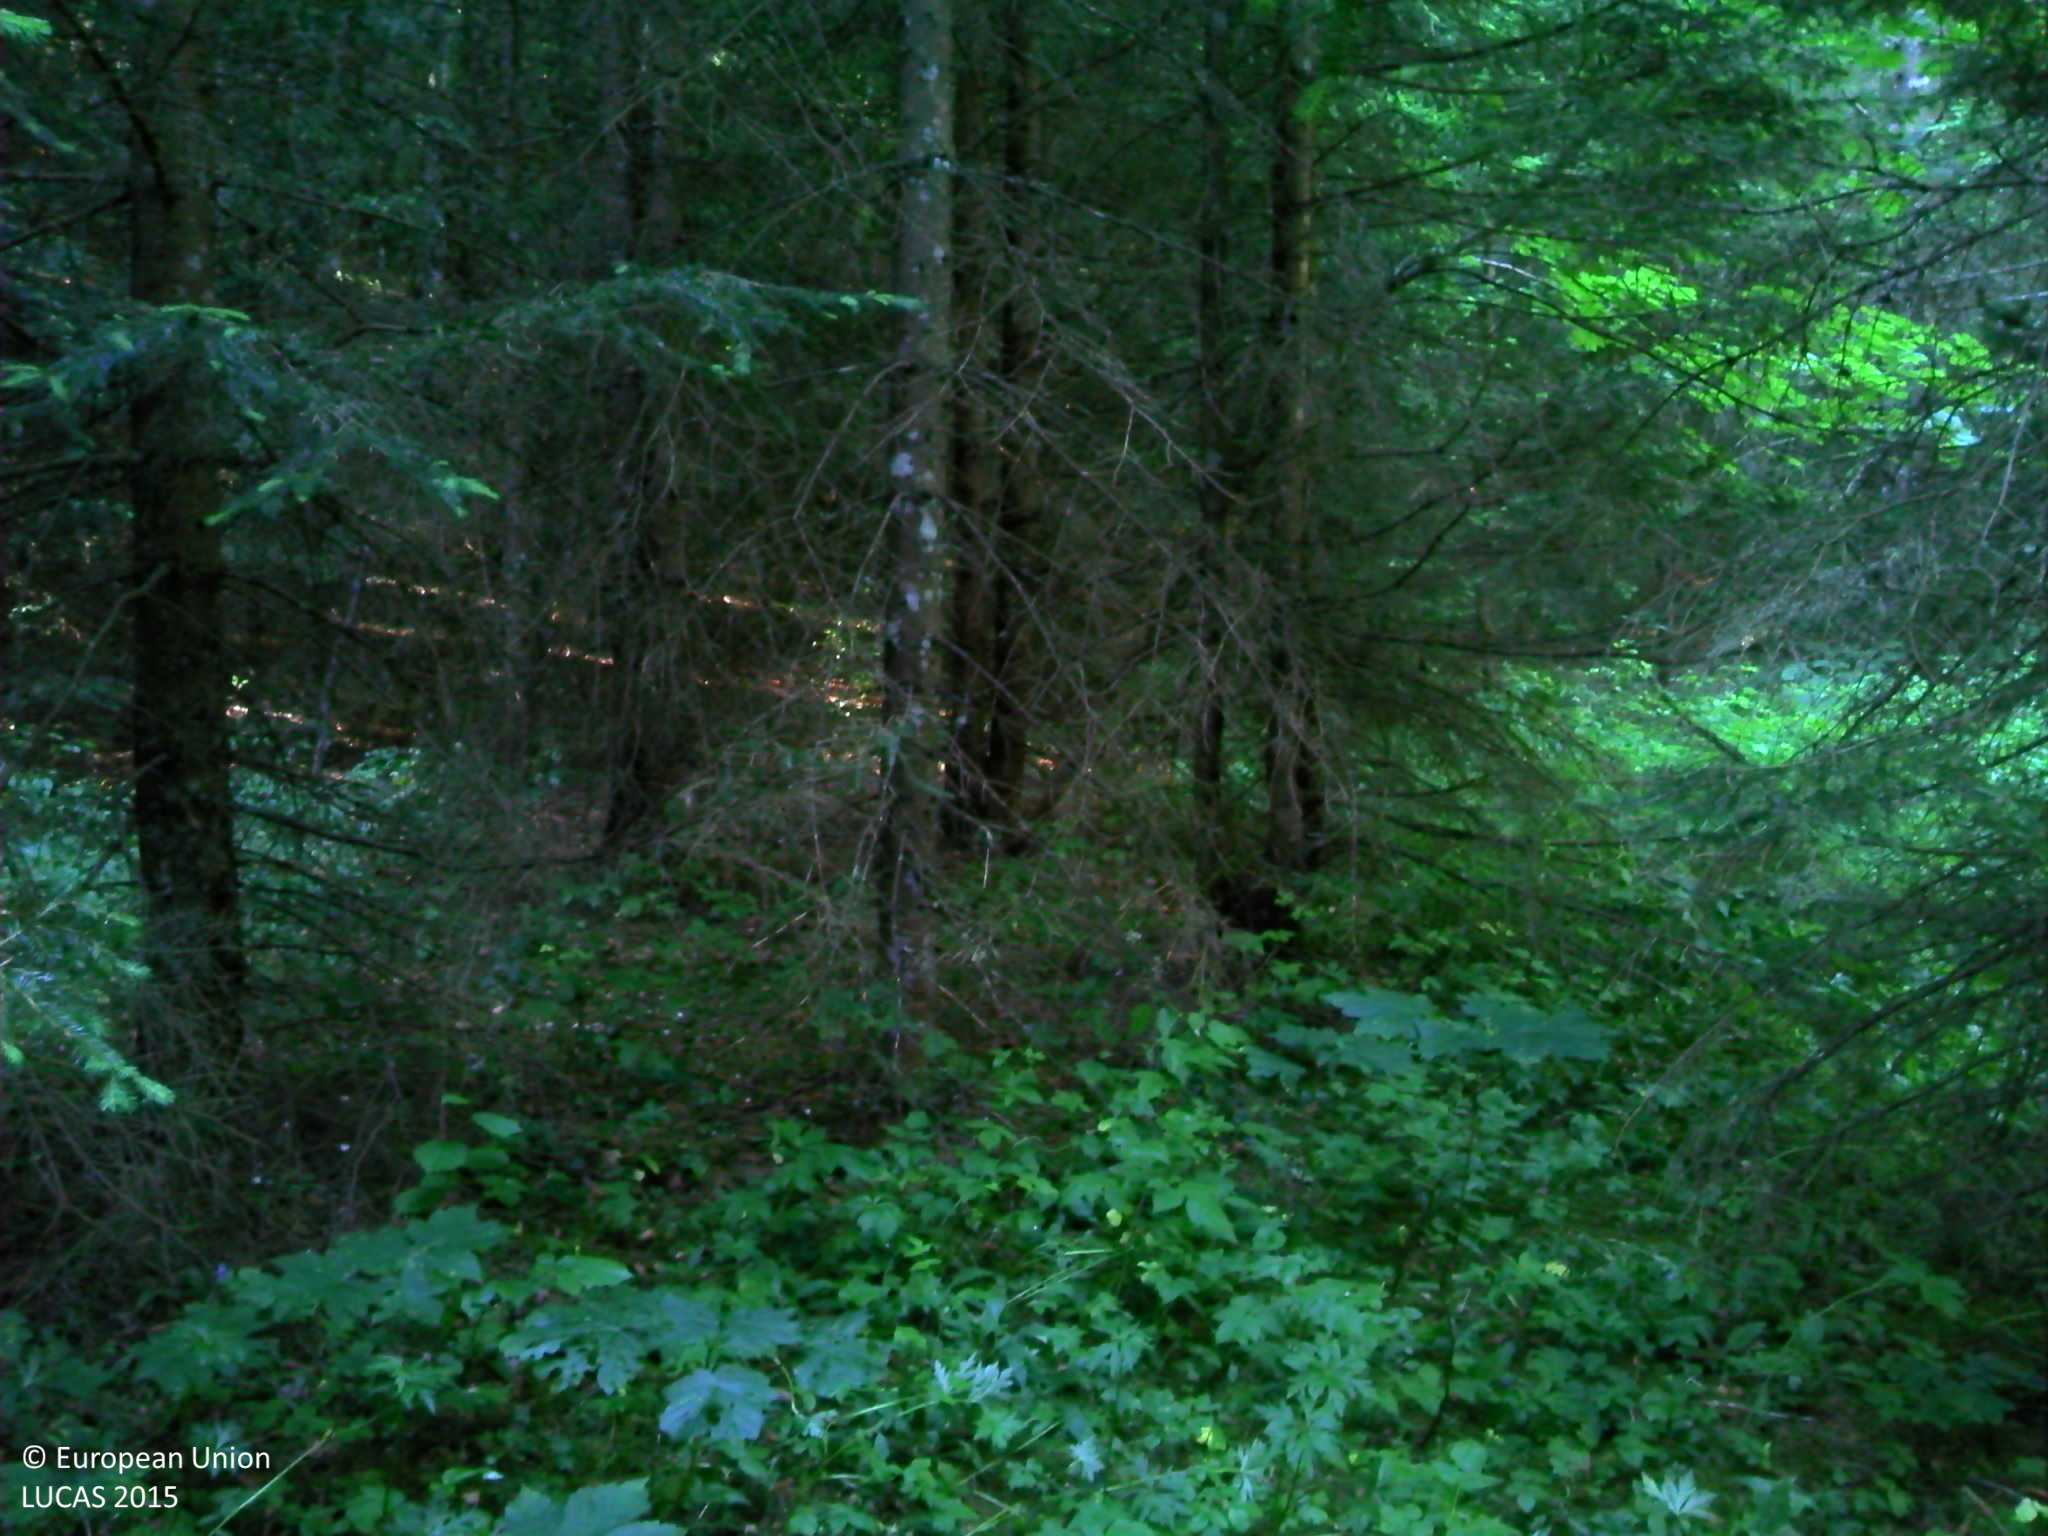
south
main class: Woodland
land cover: Spruce dominated coniferous woodland
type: alpine coniferous forest
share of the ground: > 75 %
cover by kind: coniferous forest trees 60 %, herbaceous plants 20 %, lichens and mosses 20 %
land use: Forestry
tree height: > 5 m
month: July
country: FR
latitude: 46.6397
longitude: 6.0705
